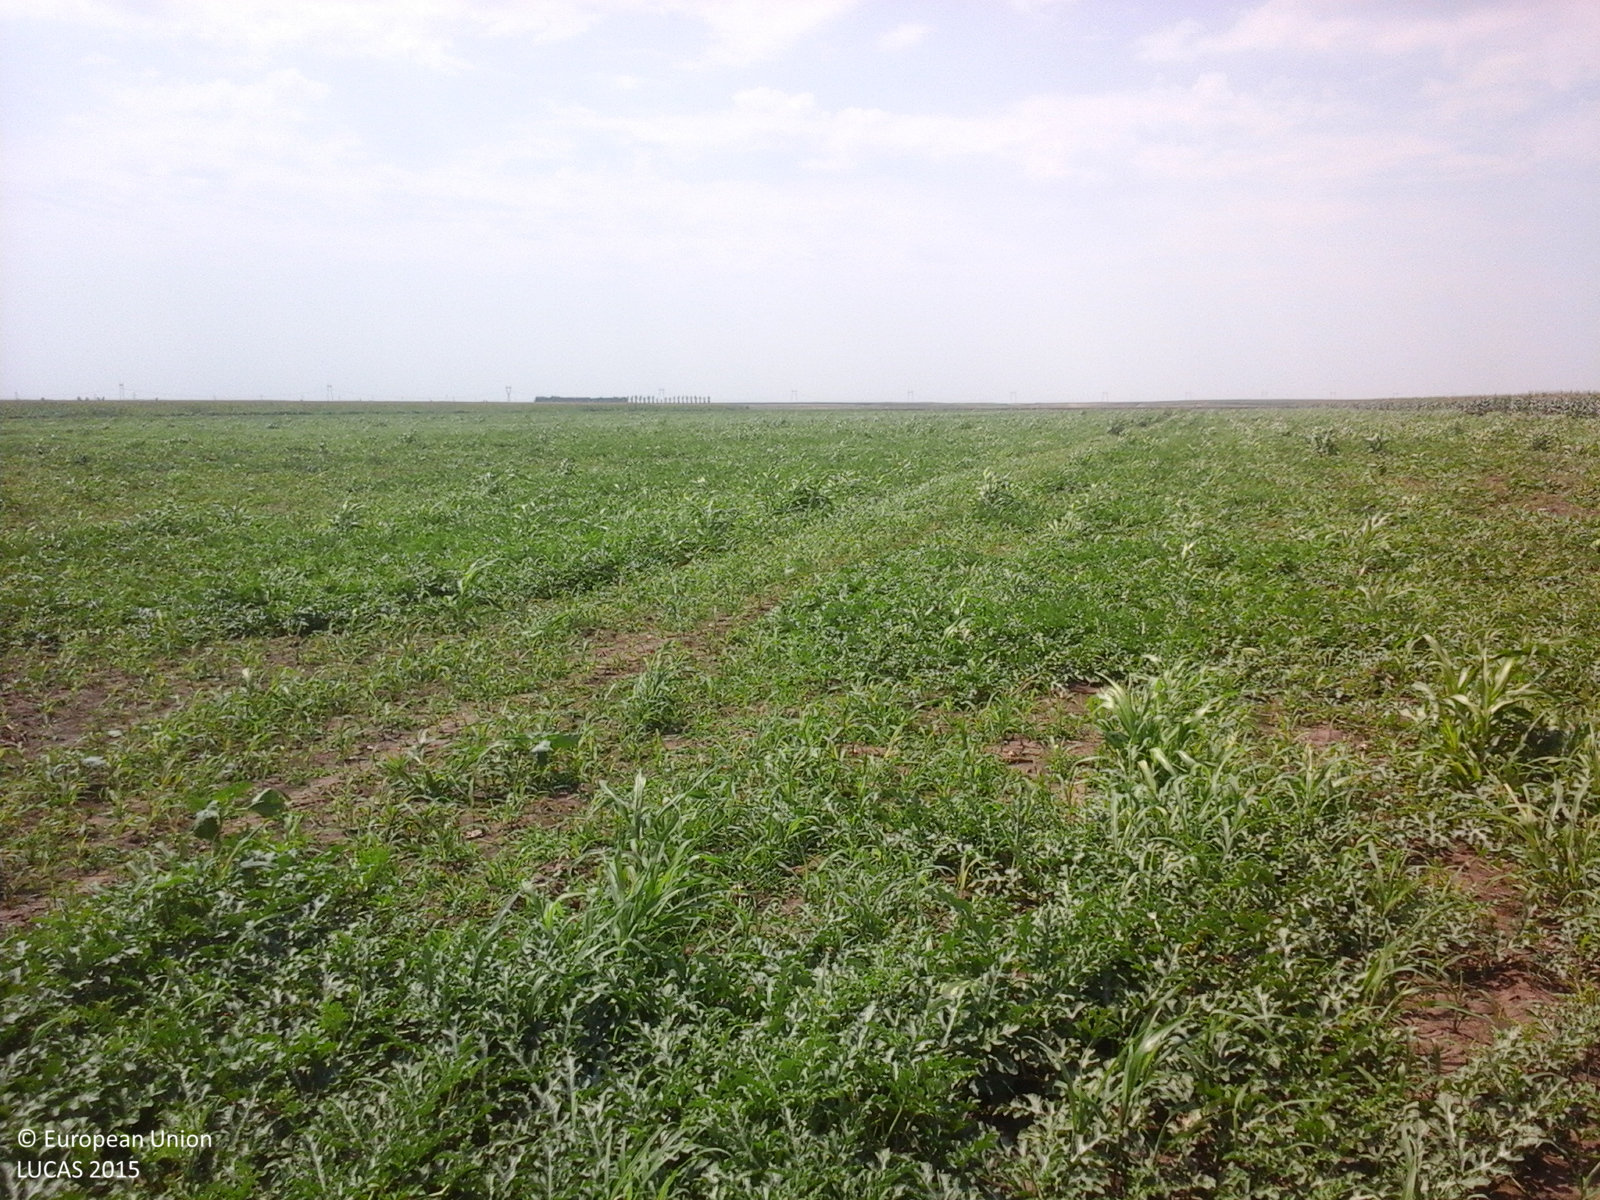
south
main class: Cropland
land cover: Other fresh vegetables
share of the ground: > 75 %
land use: Agriculture (excluding fallow land and kitchen gardens)
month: July
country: RO
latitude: 44.6412
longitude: 27.1417
